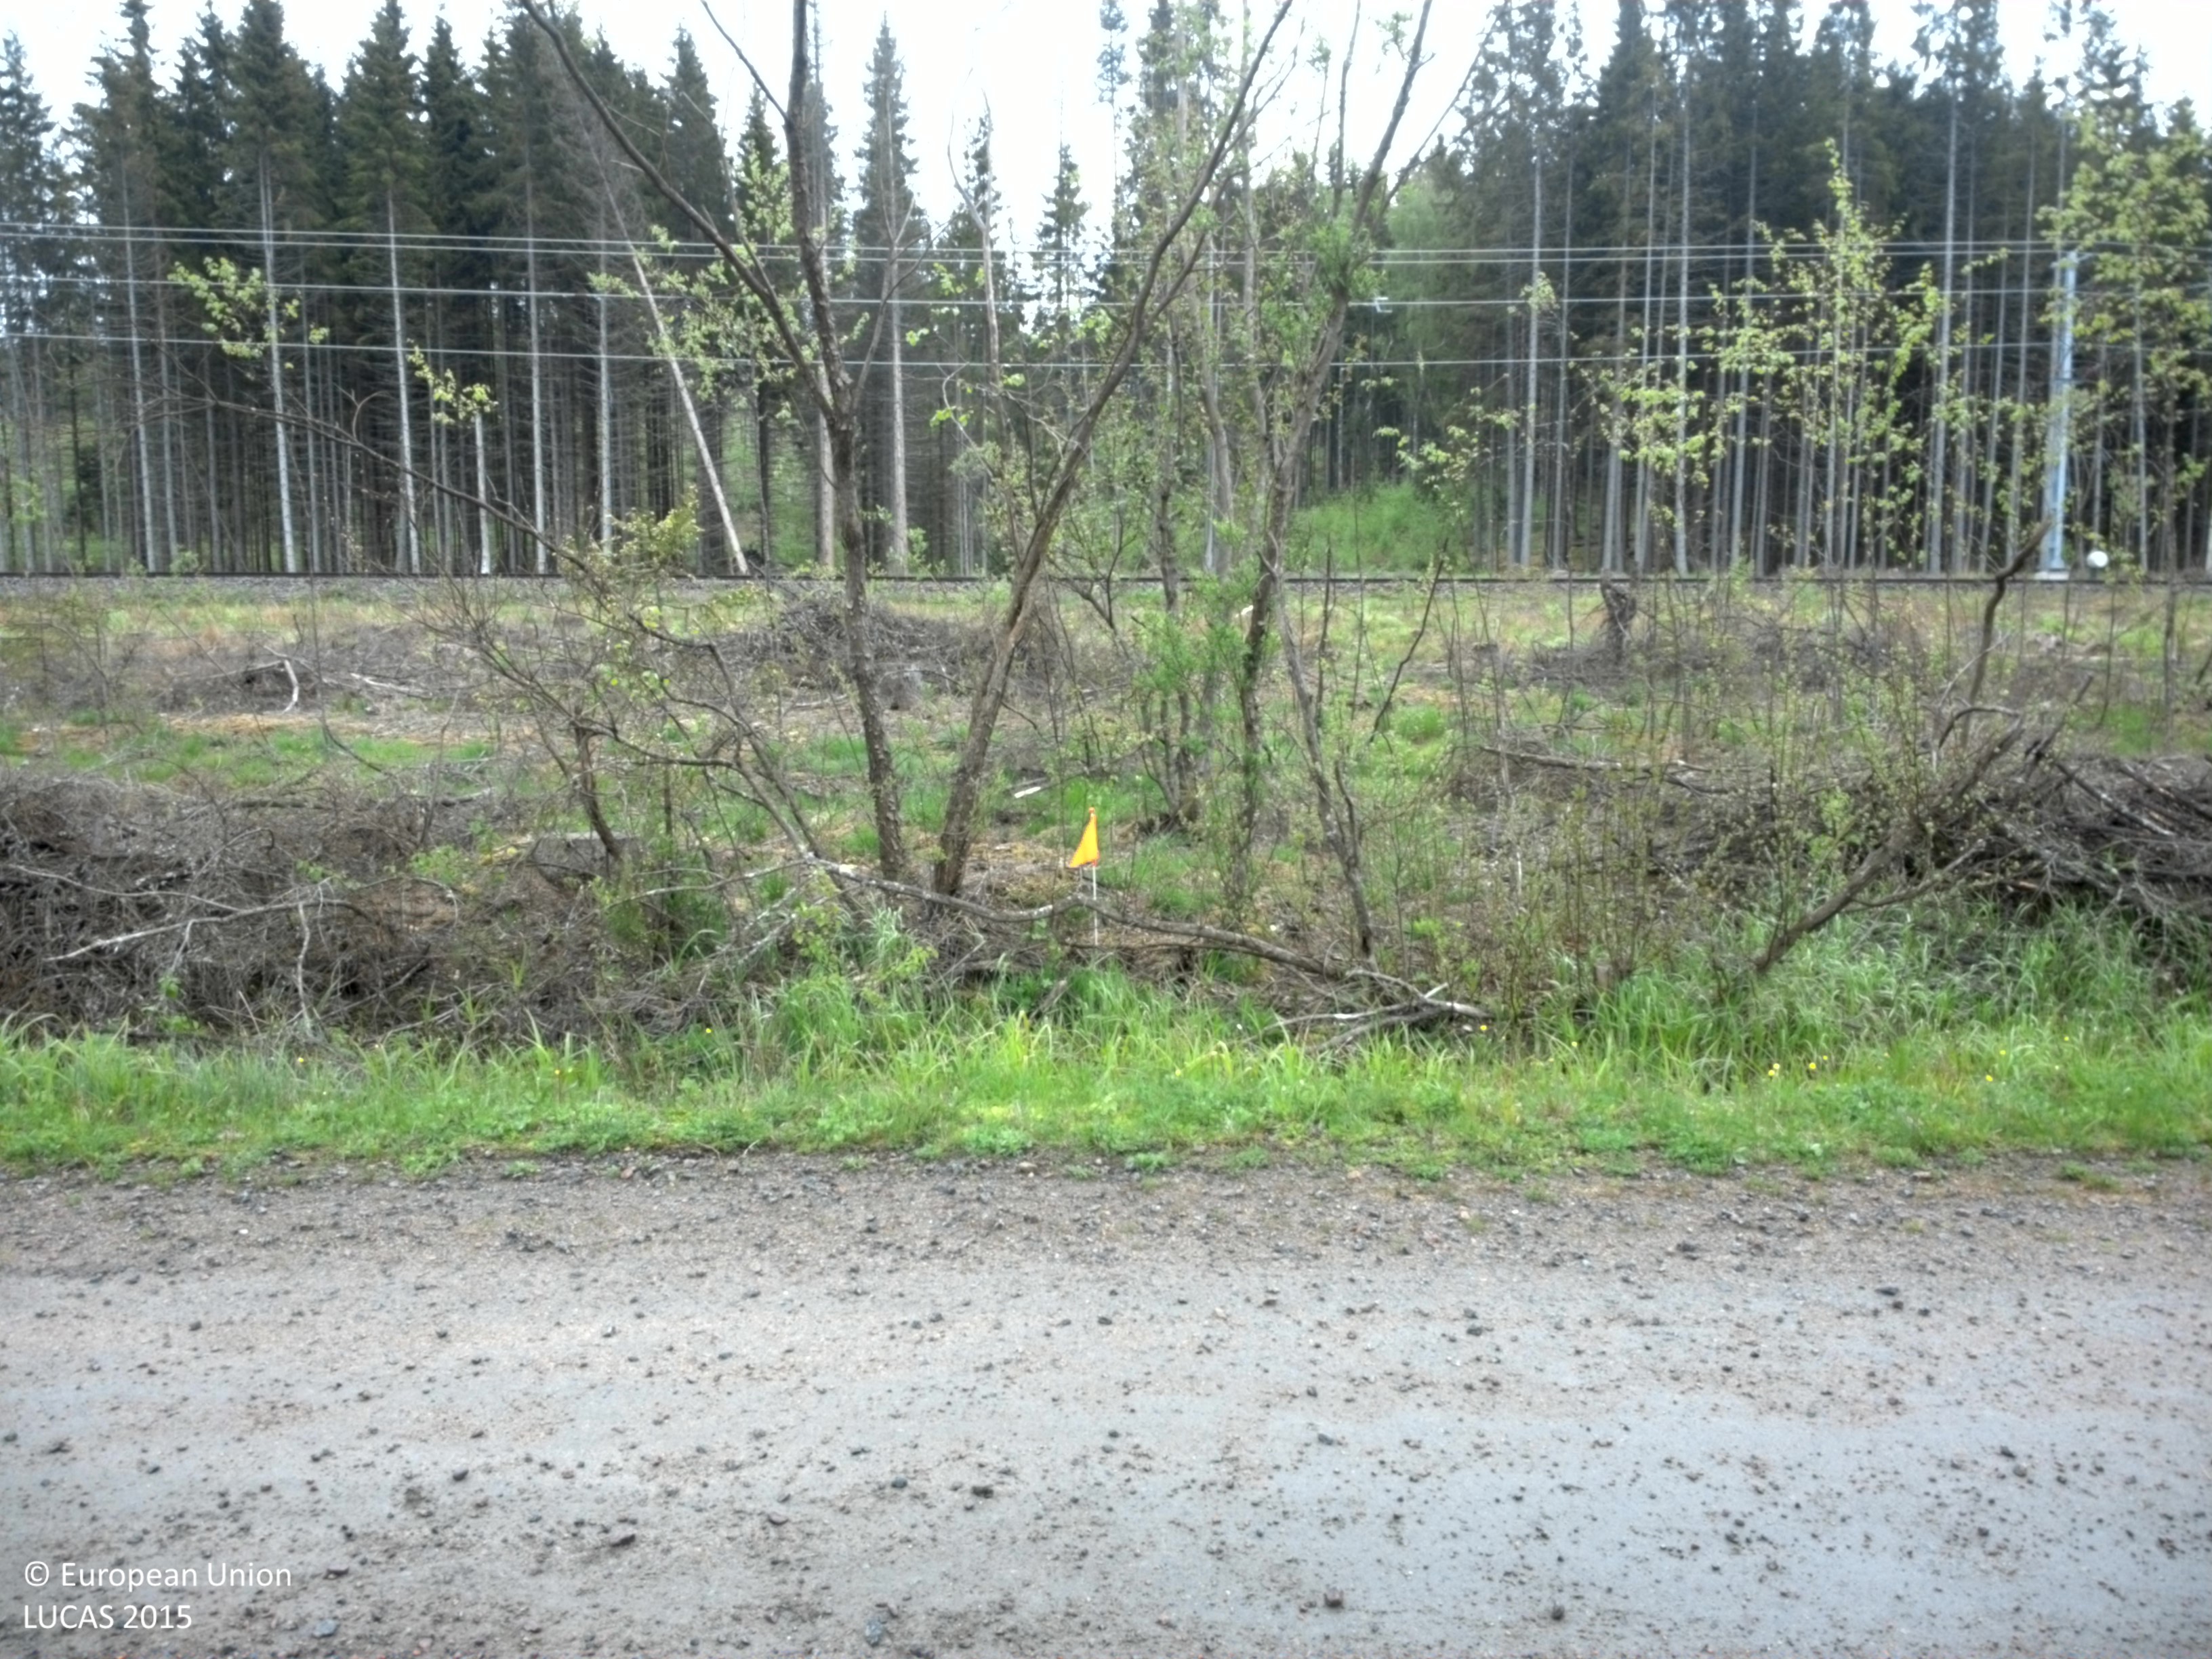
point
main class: Woodland
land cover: Broadleaved woodland
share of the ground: 25 - 50 %
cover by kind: herbaceous plants 40 %, broadleaved forest trees 35 %, lichens and mosses 15 %, coniferous forest trees 5 %, shrubs 5 %
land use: Forestry
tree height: > 5 m
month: May
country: SE
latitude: 59.3623
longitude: 14.1610
